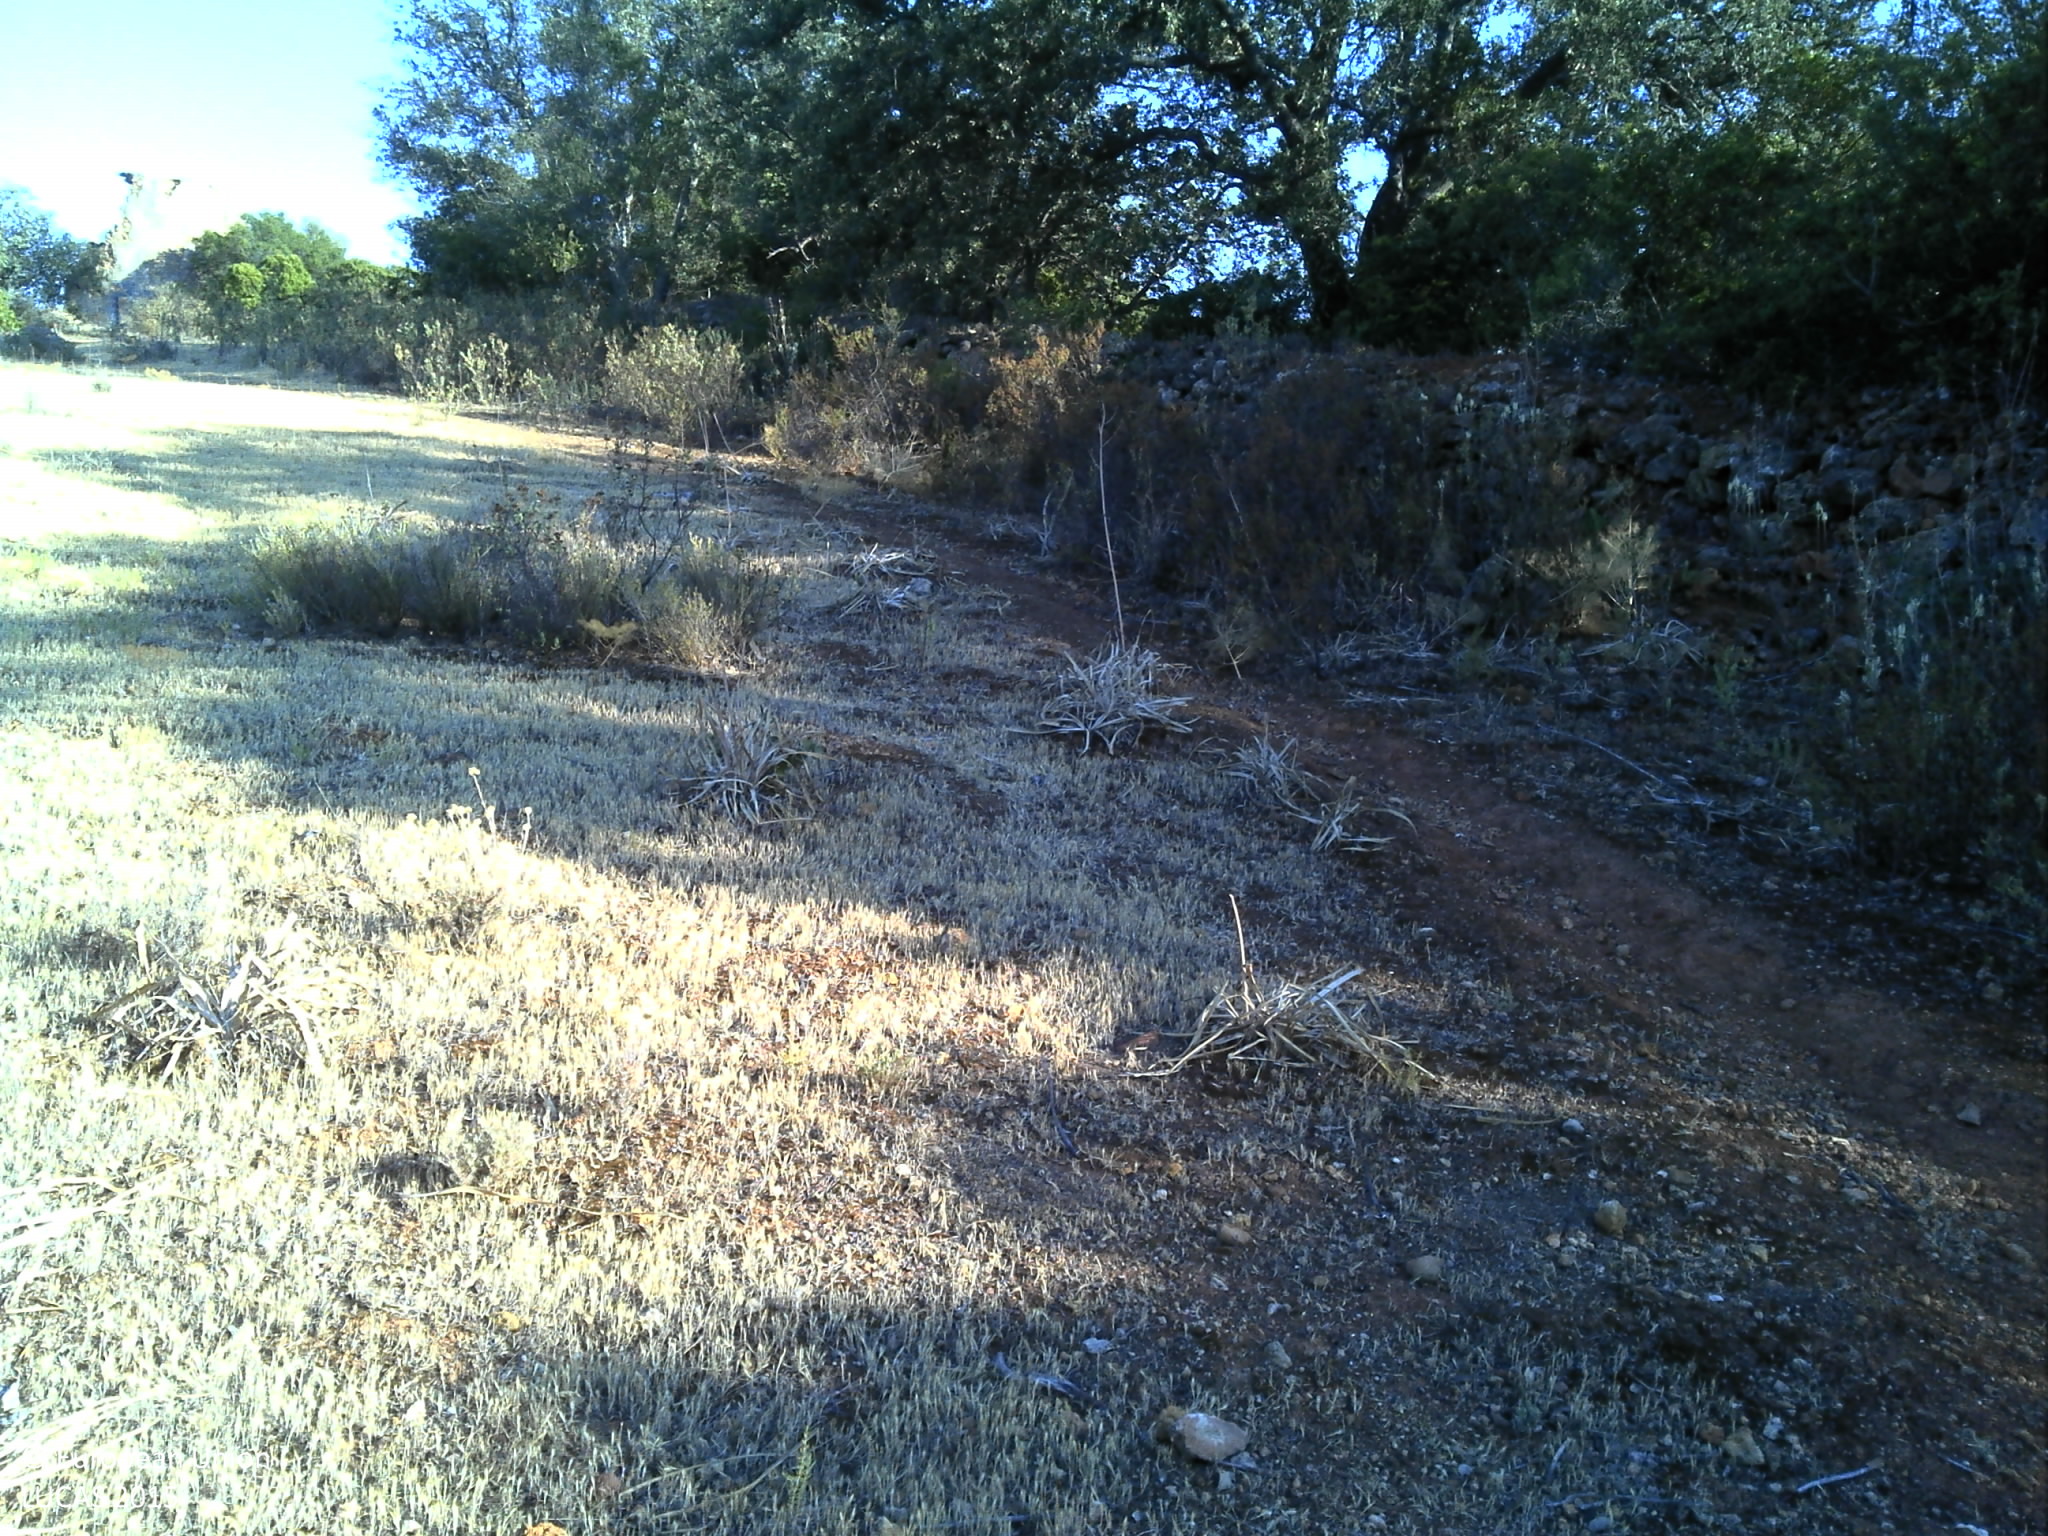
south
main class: Woodland
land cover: Broadleaved woodland
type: broadleaved evergreen forest
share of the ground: 10 - 25 %
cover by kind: unconsolidated bare surface 50 %, broadleaved forest trees 25 %, herbaceous plants 25 %
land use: Forestry
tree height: < 5 m
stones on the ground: < 10 %
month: June
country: PT
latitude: 37.0736
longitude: -7.7895
